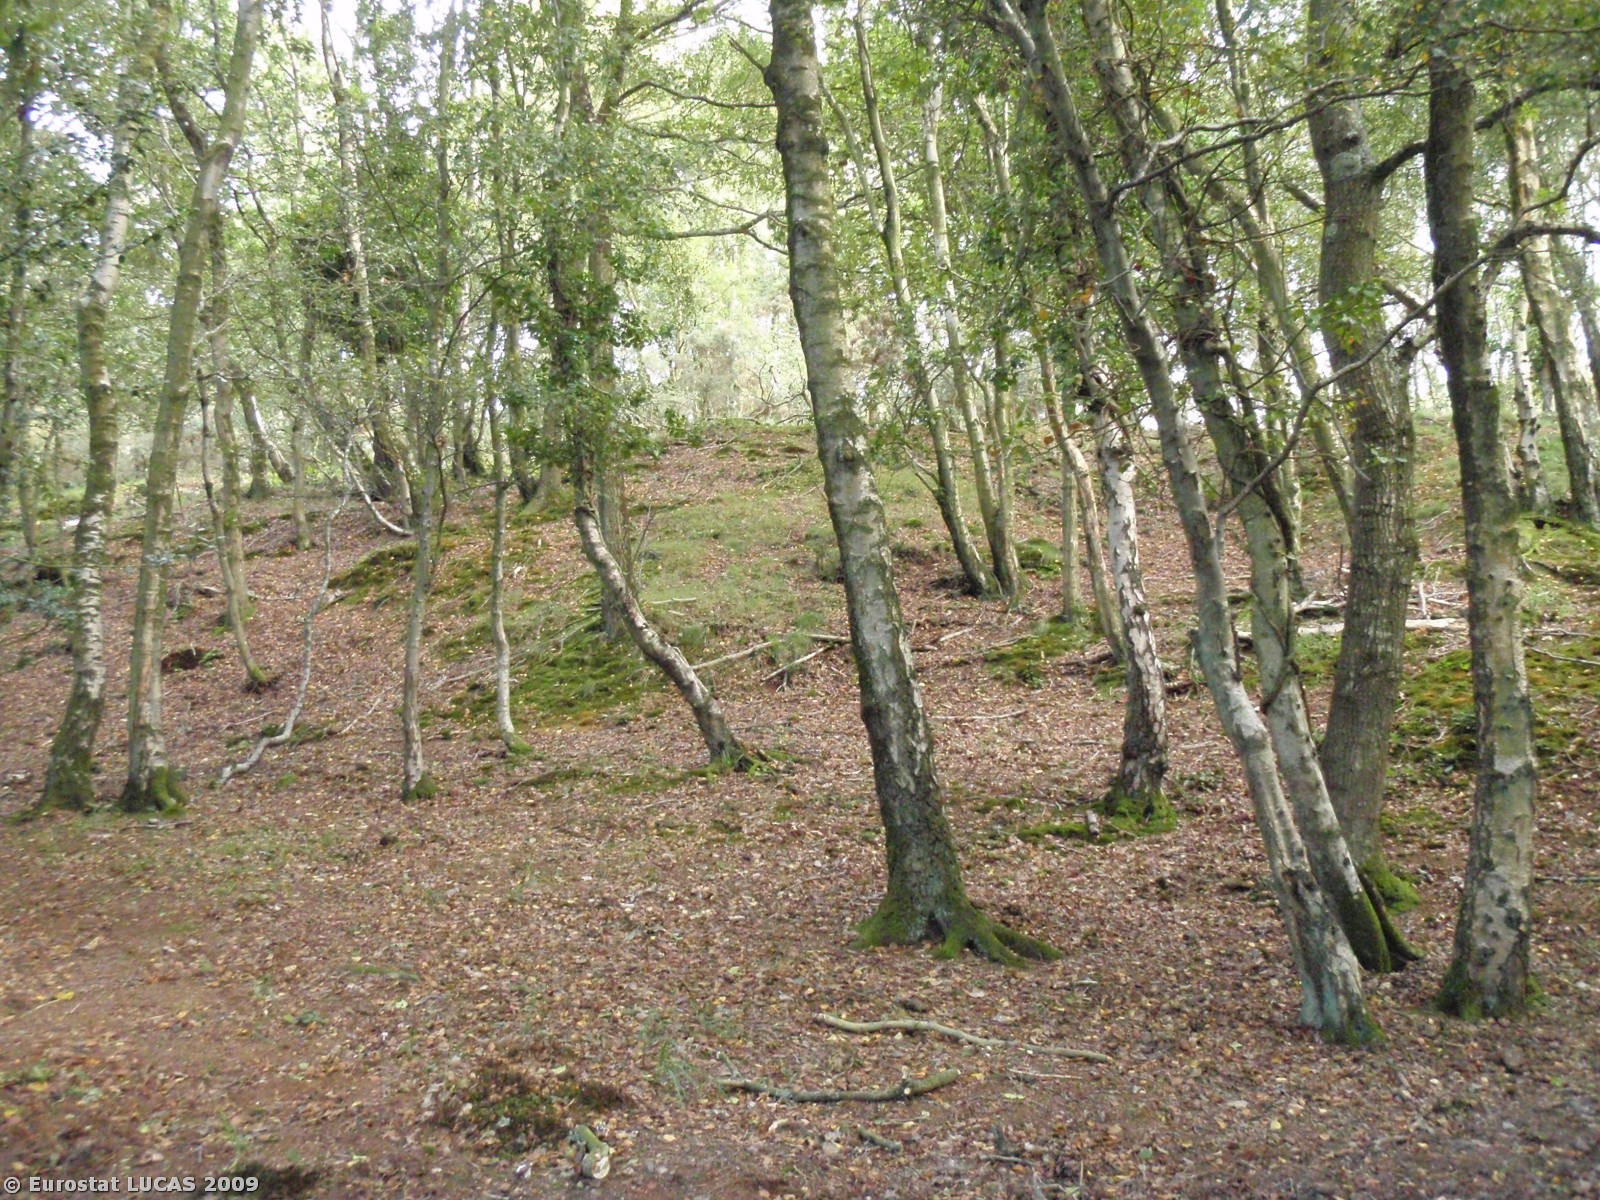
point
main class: Woodland
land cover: Broadleaved woodland
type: acidophilous oak and oak-birch forest
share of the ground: > 75 %
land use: Unused
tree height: > 5 m
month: September
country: GB
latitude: 50.6469
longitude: -2.0947
